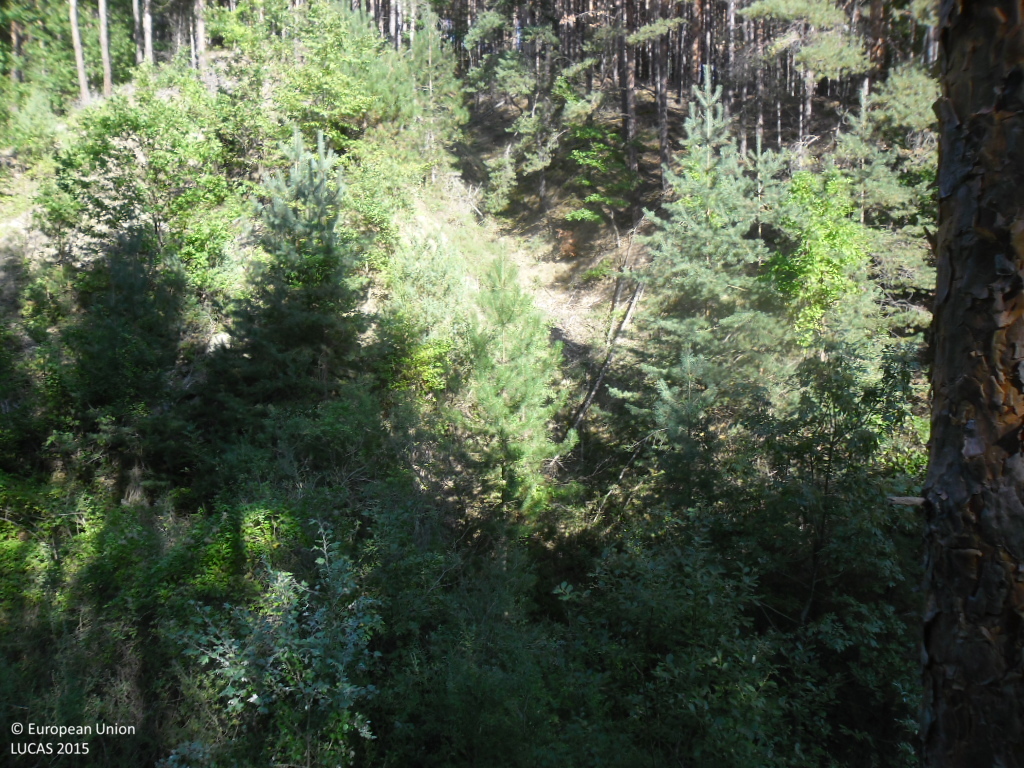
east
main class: Woodland
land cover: Pine dominated coniferous woodland
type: hemiboreal forest and nemoral coniferous forest and mixed broadleaved-coniferous forest
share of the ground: > 75 %
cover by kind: coniferous forest trees 100 %
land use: Forestry
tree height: > 5 m
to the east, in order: Pine dominated coniferous woodland; Broadleaved woodland; Inland fresh running water; Broadleaved woodland; Pine dominated coniferous woodland
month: September
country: BG
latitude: 41.7798
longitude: 23.2463
